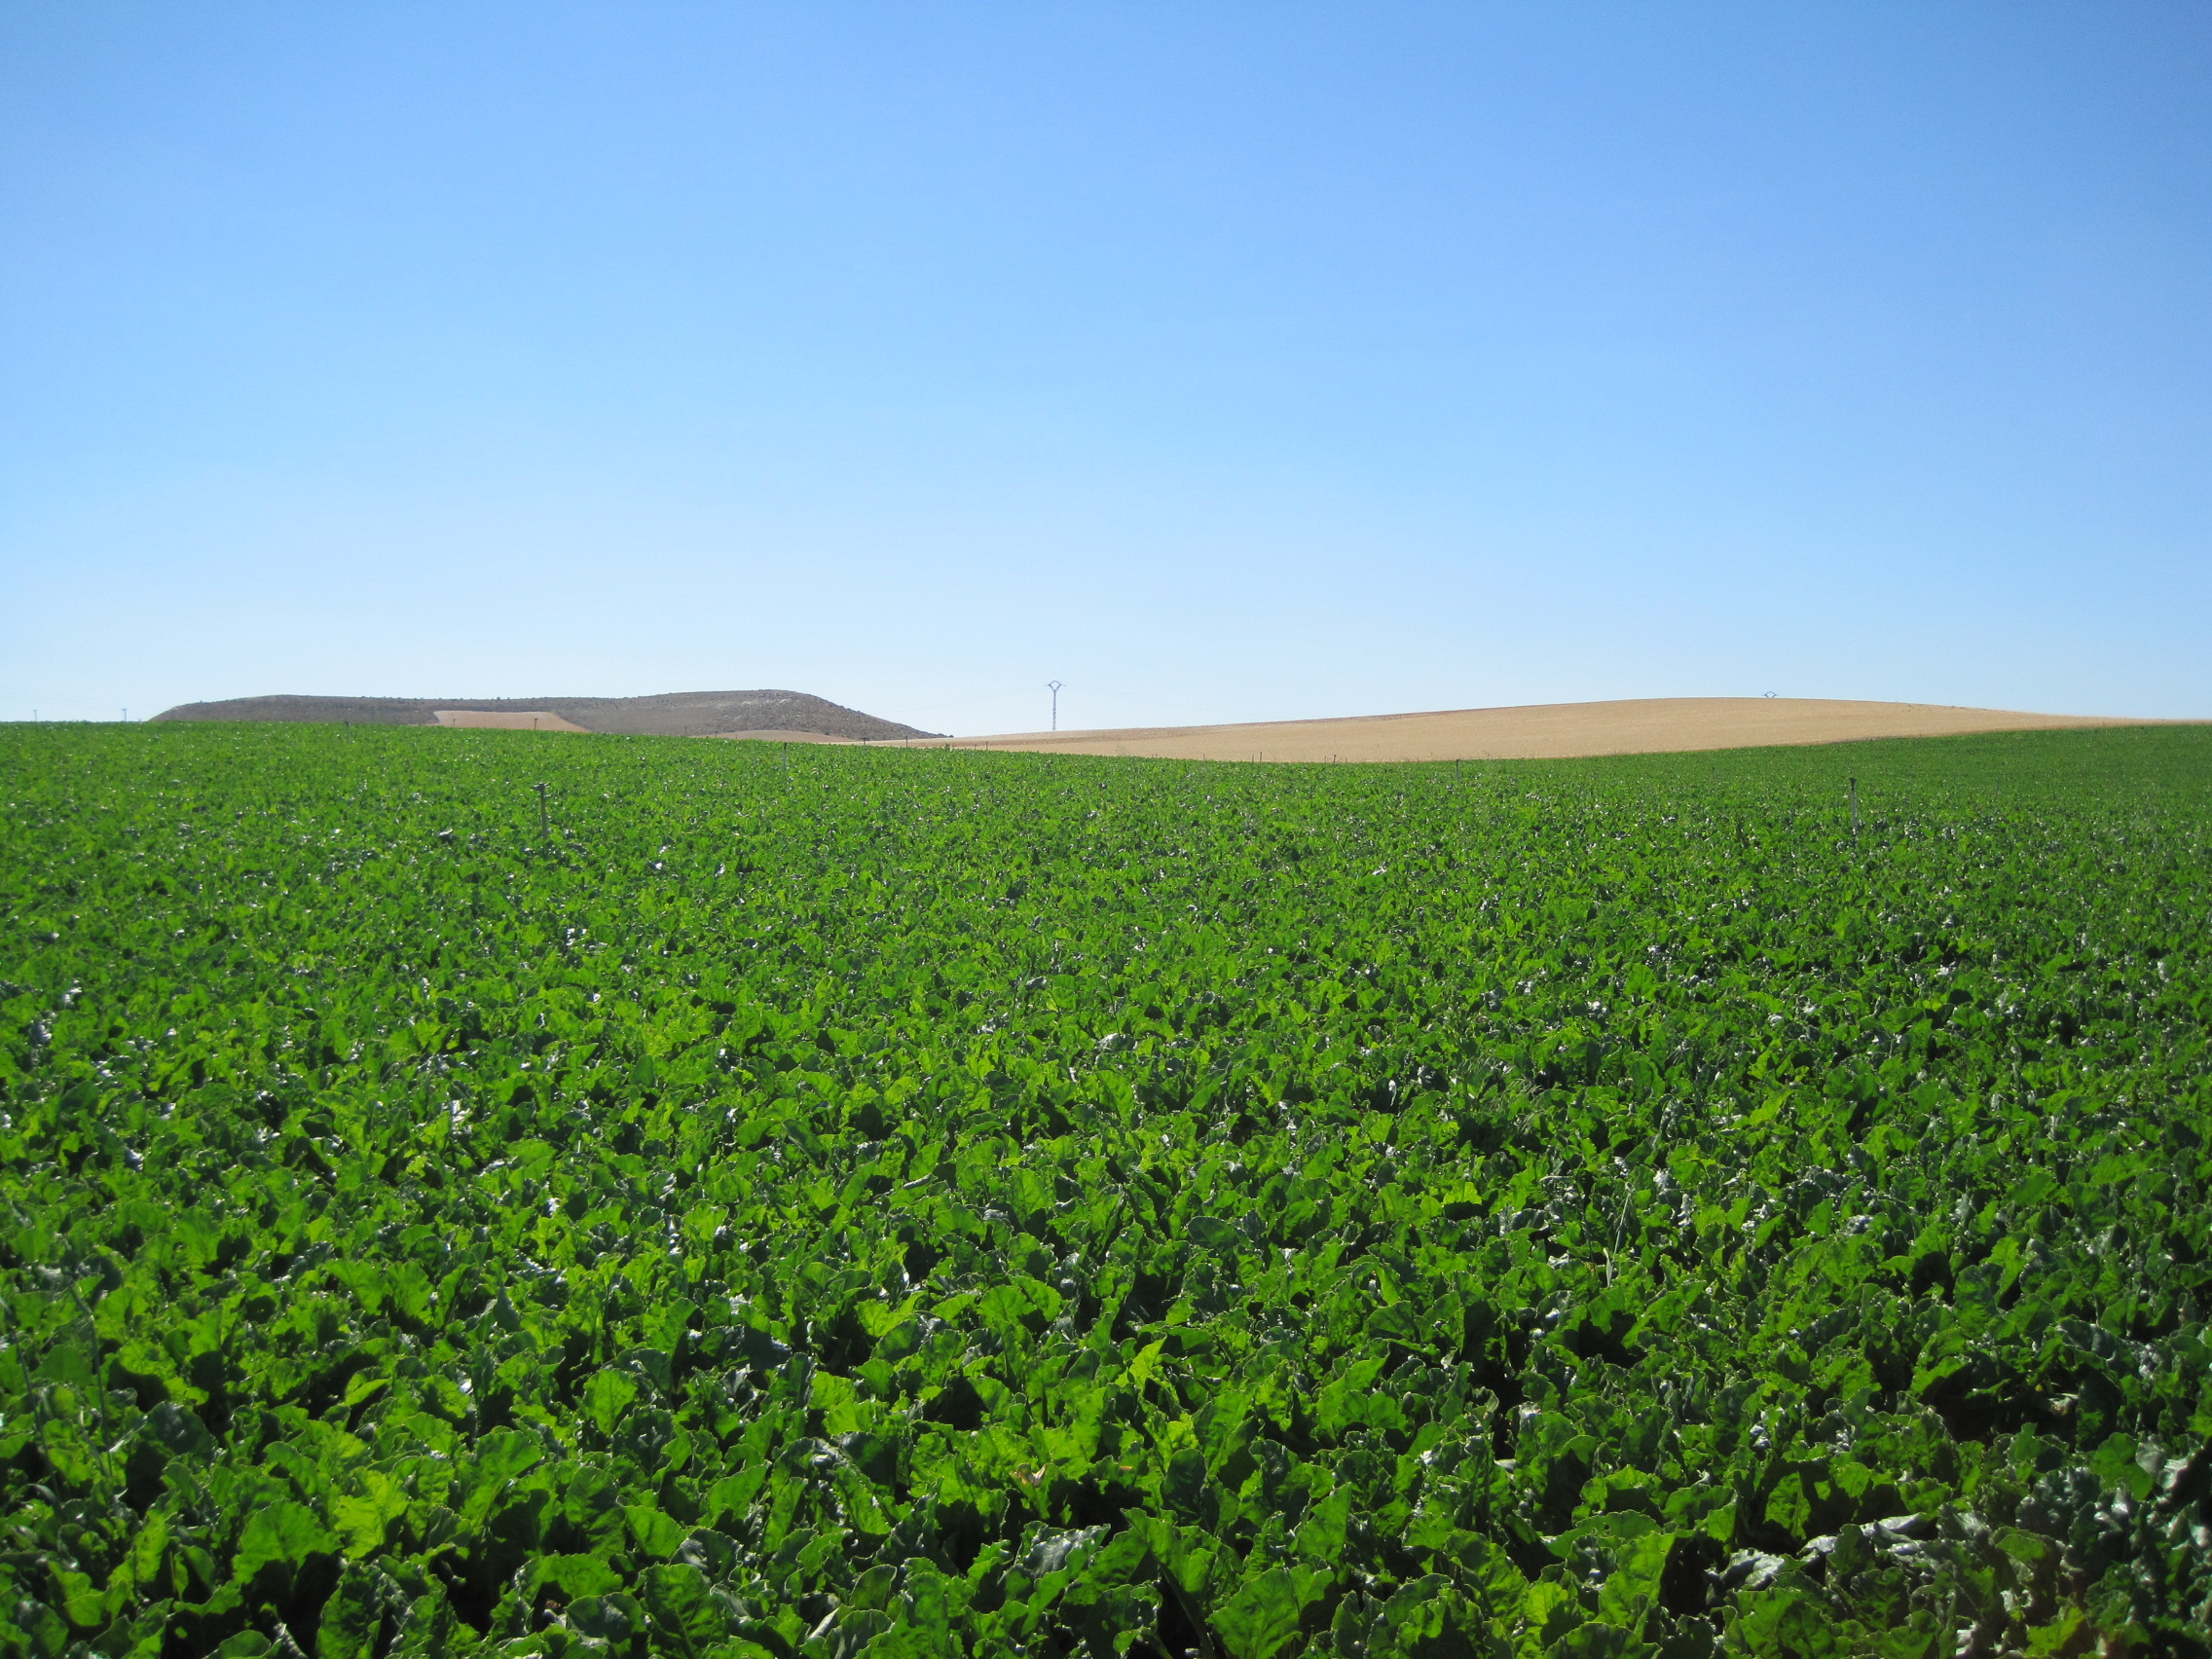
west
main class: Cropland
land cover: Sugar beet
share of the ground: > 75 %
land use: Agriculture (excluding fallow land and kitchen gardens)
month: June
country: ES
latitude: 41.6468
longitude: -5.1939
